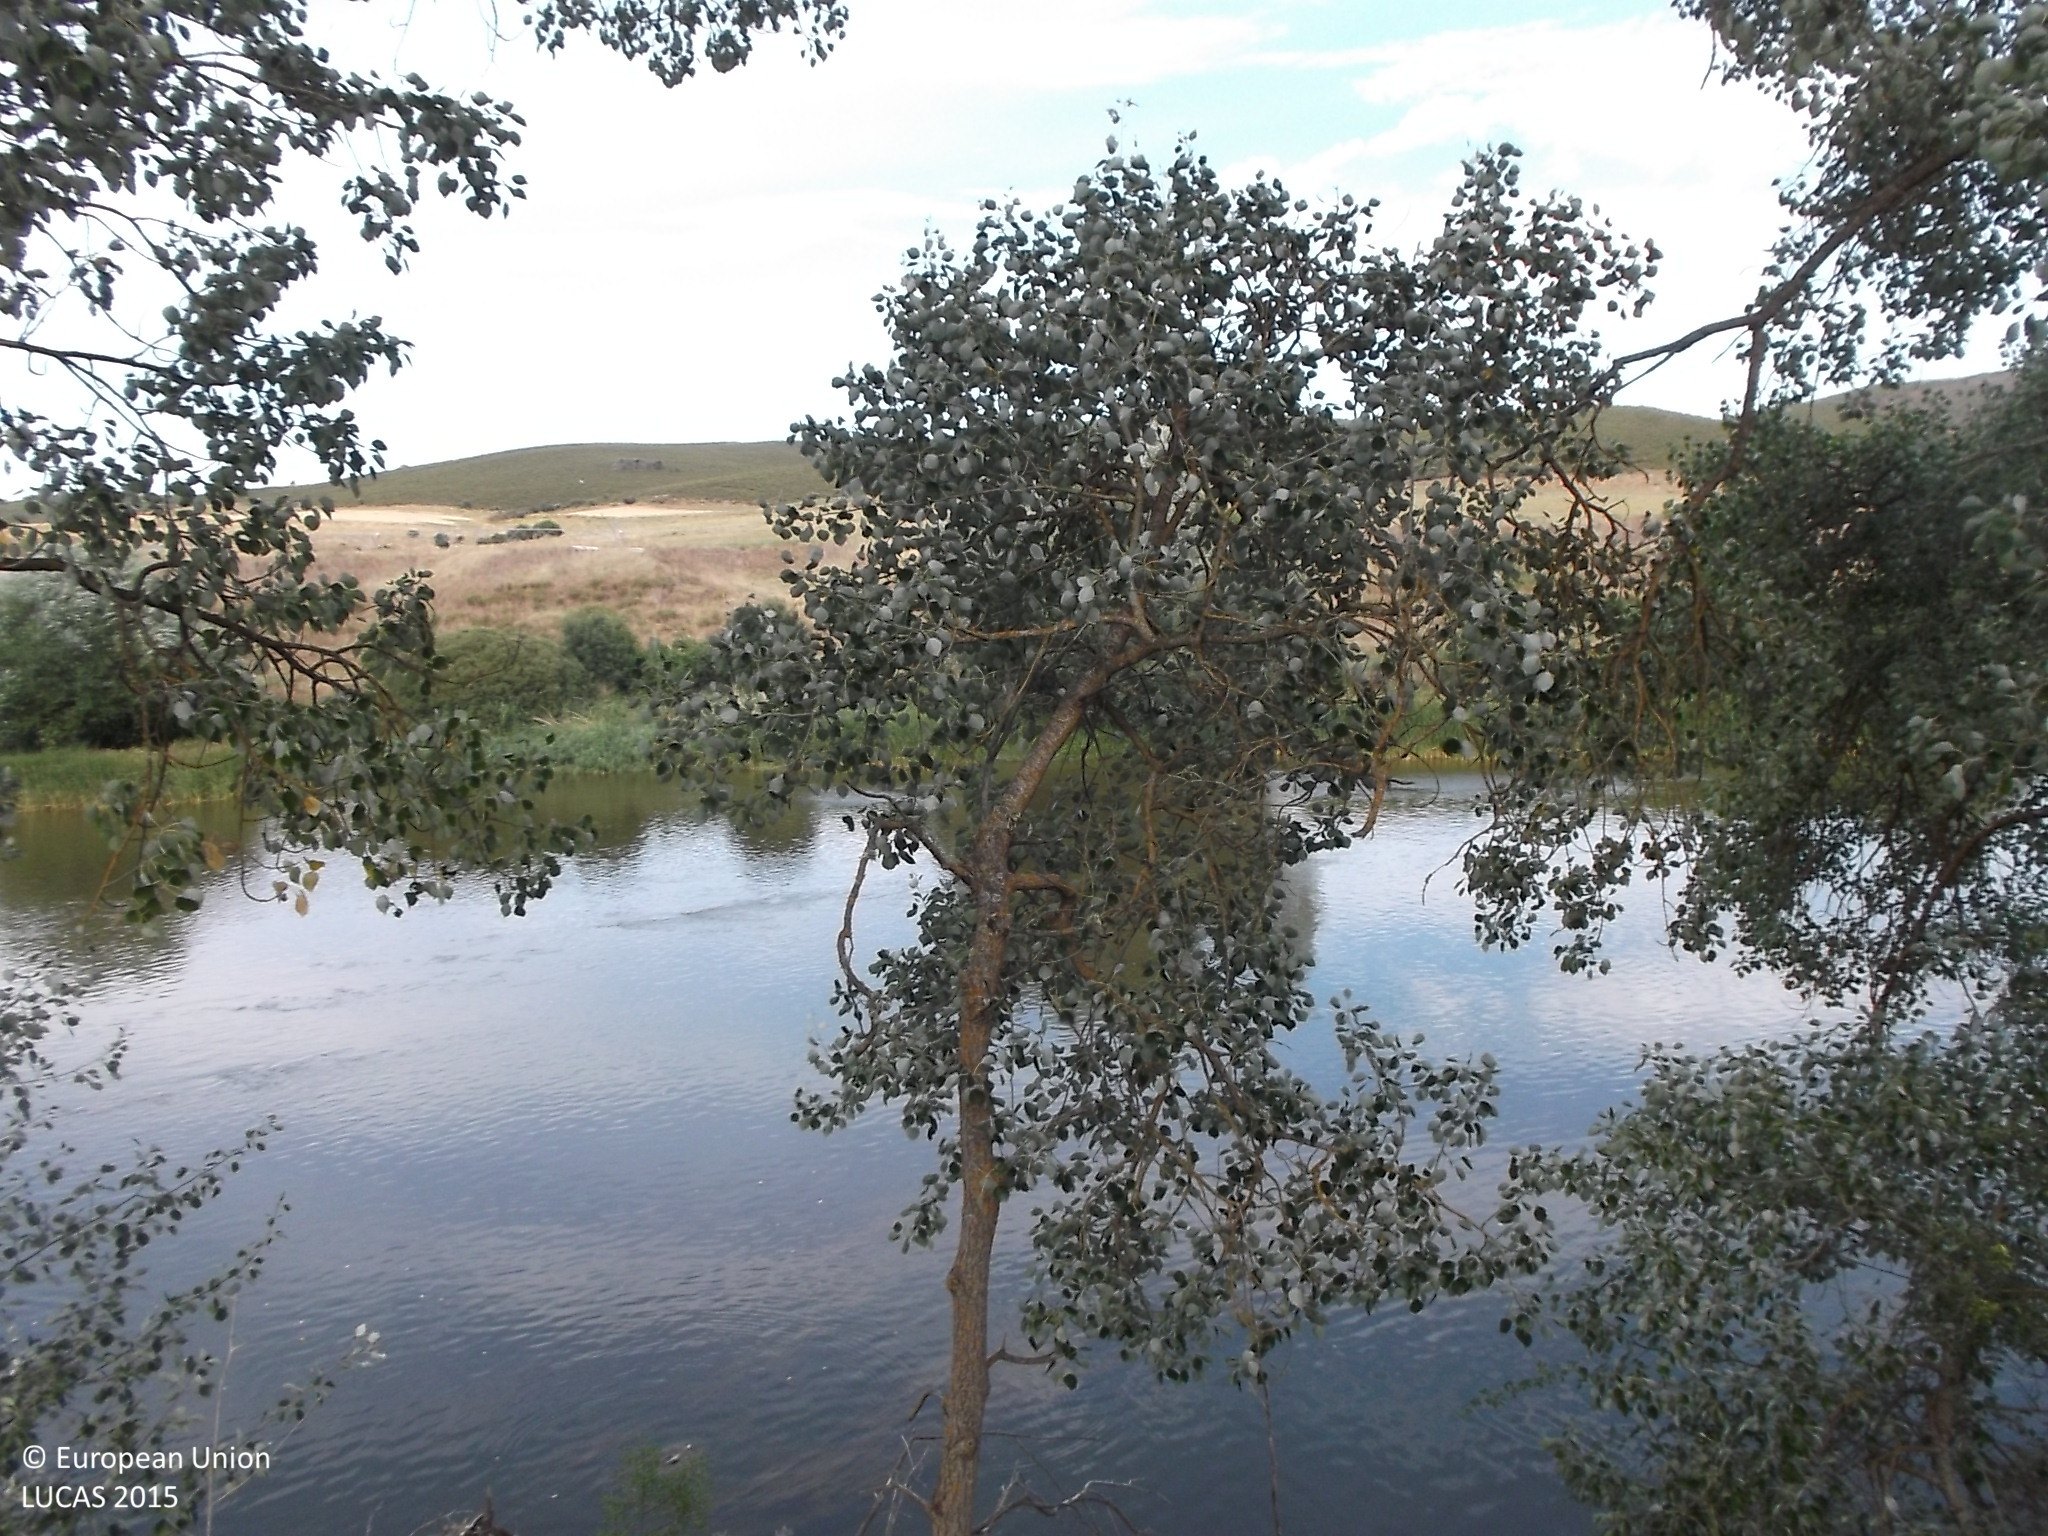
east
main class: Woodland
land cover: Broadleaved woodland
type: thermophilous deciduous forest
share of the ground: 50 - 75 %
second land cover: Grassland without tree/shrub cover
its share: 25 - 50 %
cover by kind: broadleaved forest trees 60 %, herbaceous plants 40 %
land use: Forestry
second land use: Agriculture (excluding fallow land and kitchen gardens)
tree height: > 5 m
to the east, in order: Broadleaved woodland; Grassland without tree/shrub cover; Inland fresh running water; Shrubland without tree cover; Grassland without tree/shrub cover
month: July
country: ES
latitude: 41.4828
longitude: -5.8858
